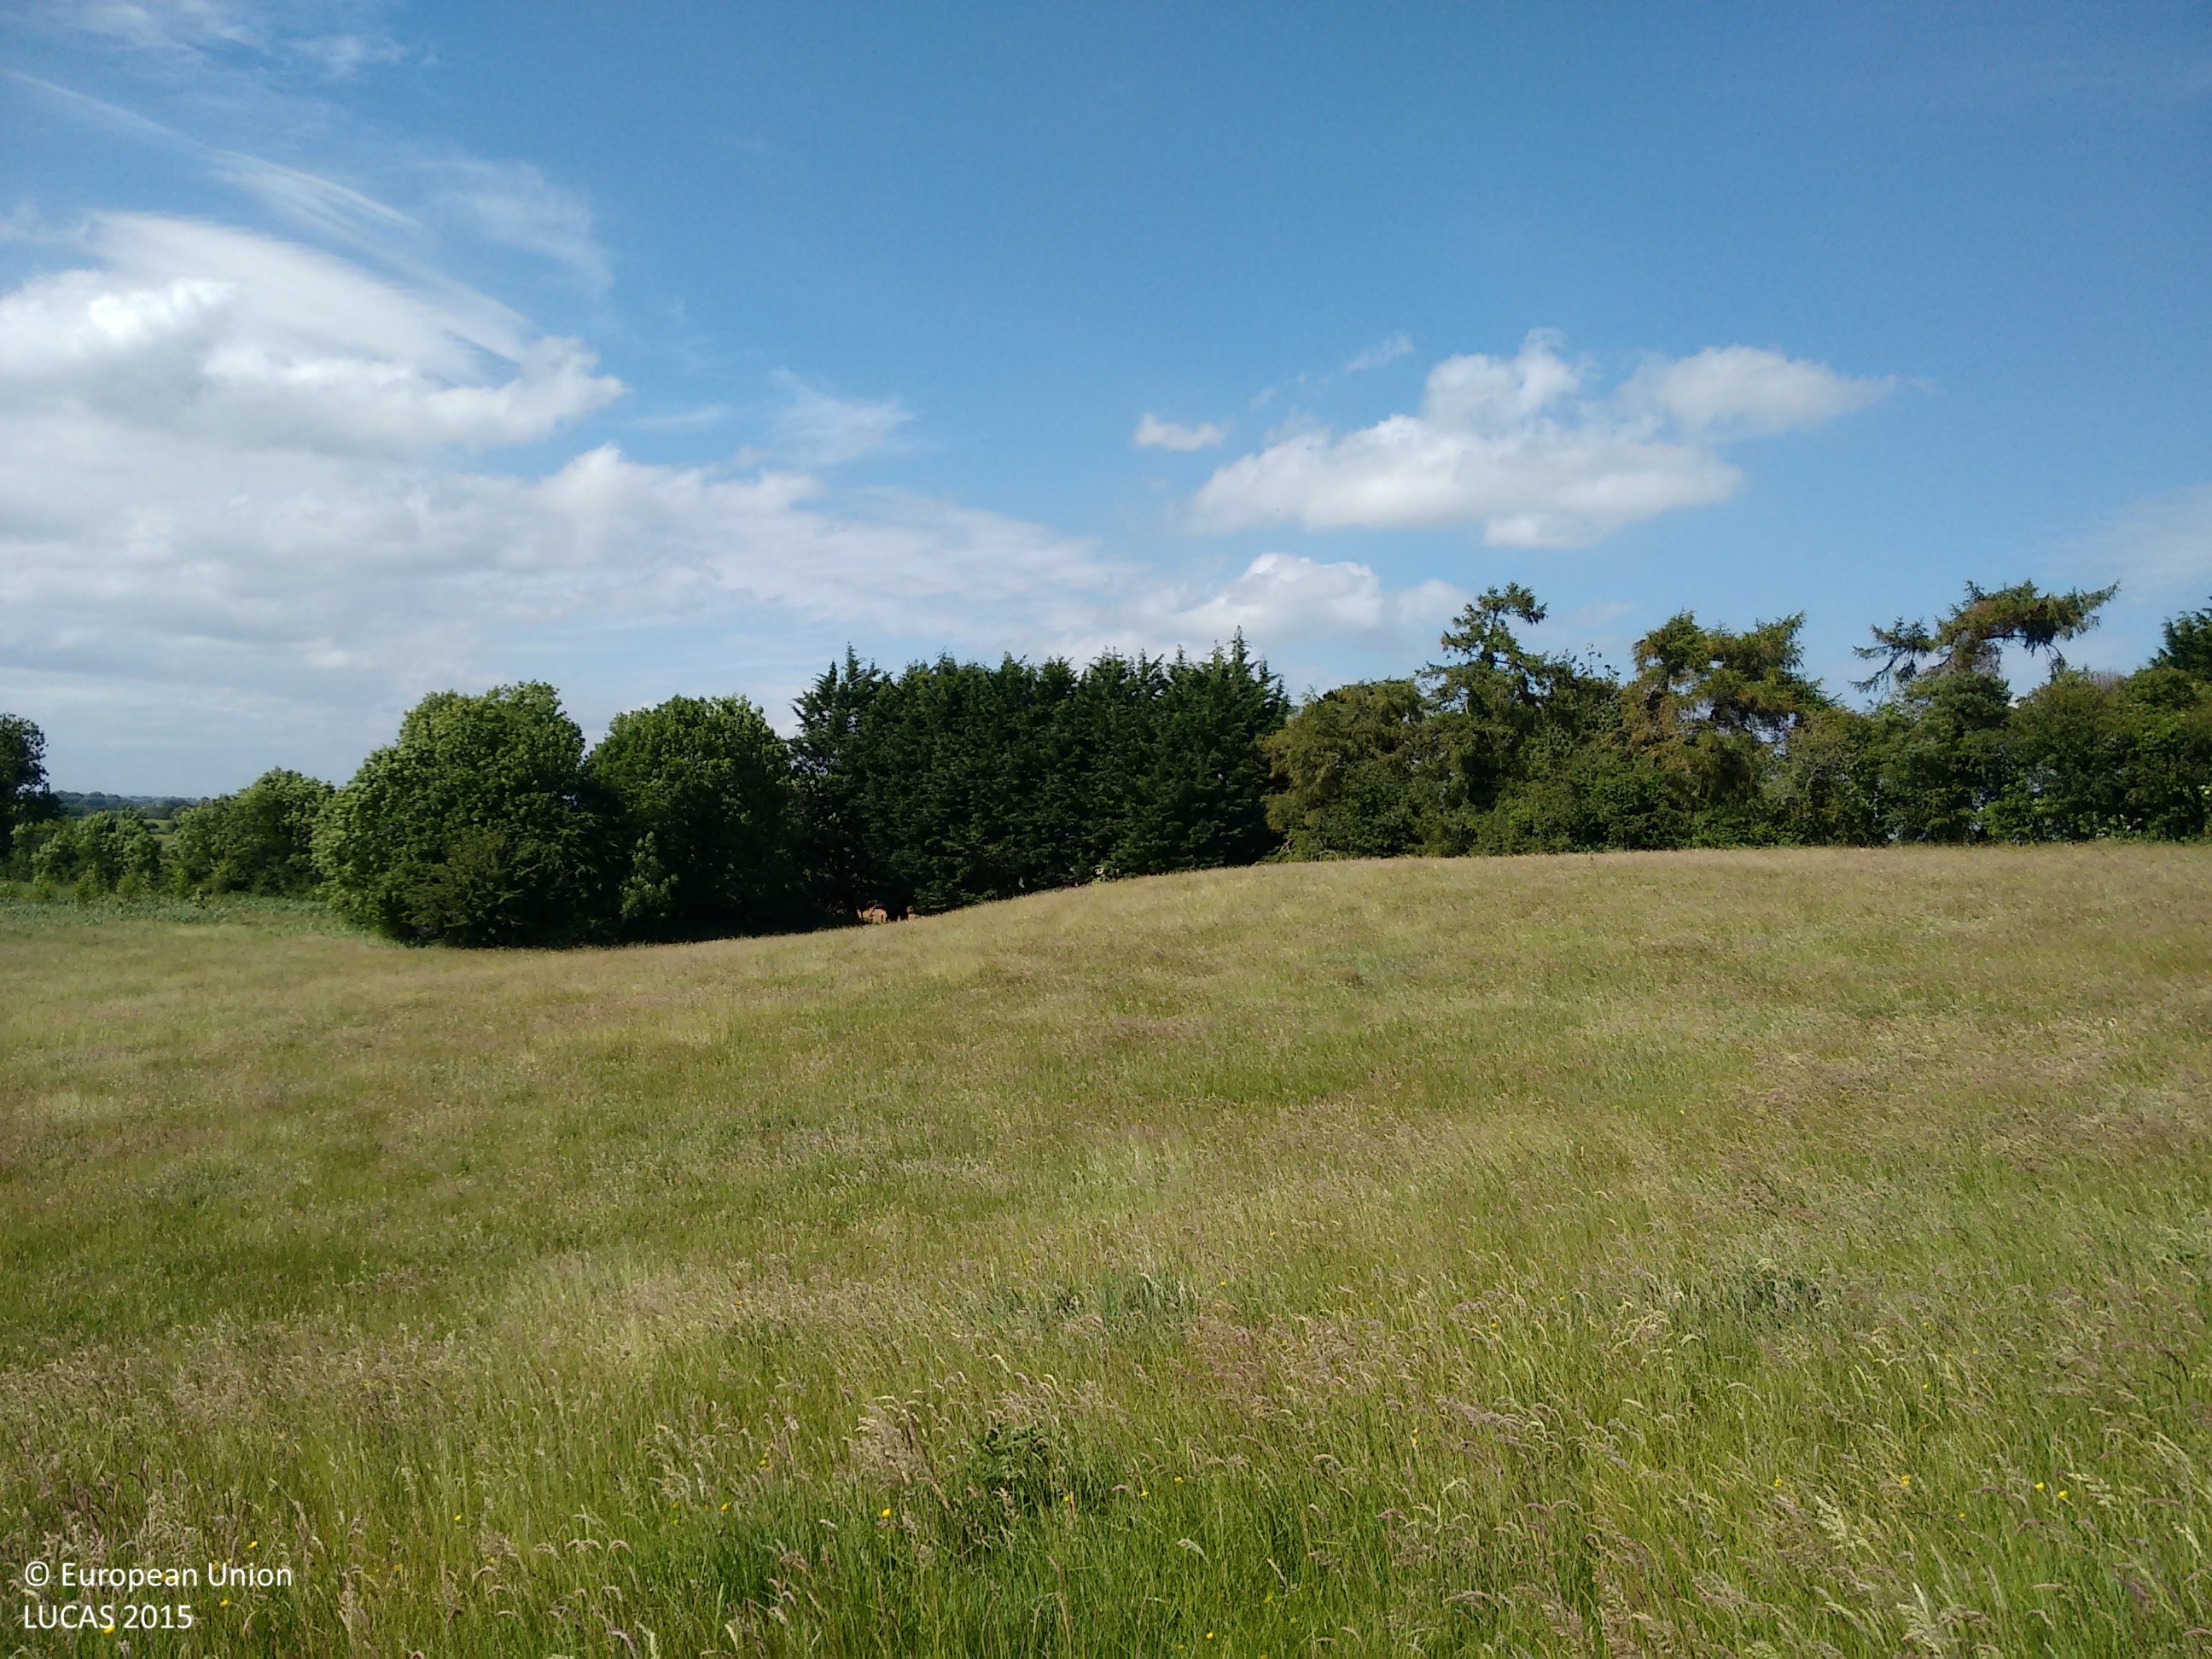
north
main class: Grassland
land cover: Grassland without tree/shrub cover
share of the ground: > 75 %
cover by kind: herbaceous plants 100 %
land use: Agriculture (excluding fallow land and kitchen gardens)
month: June
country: IE
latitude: 53.4374
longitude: -7.7643
